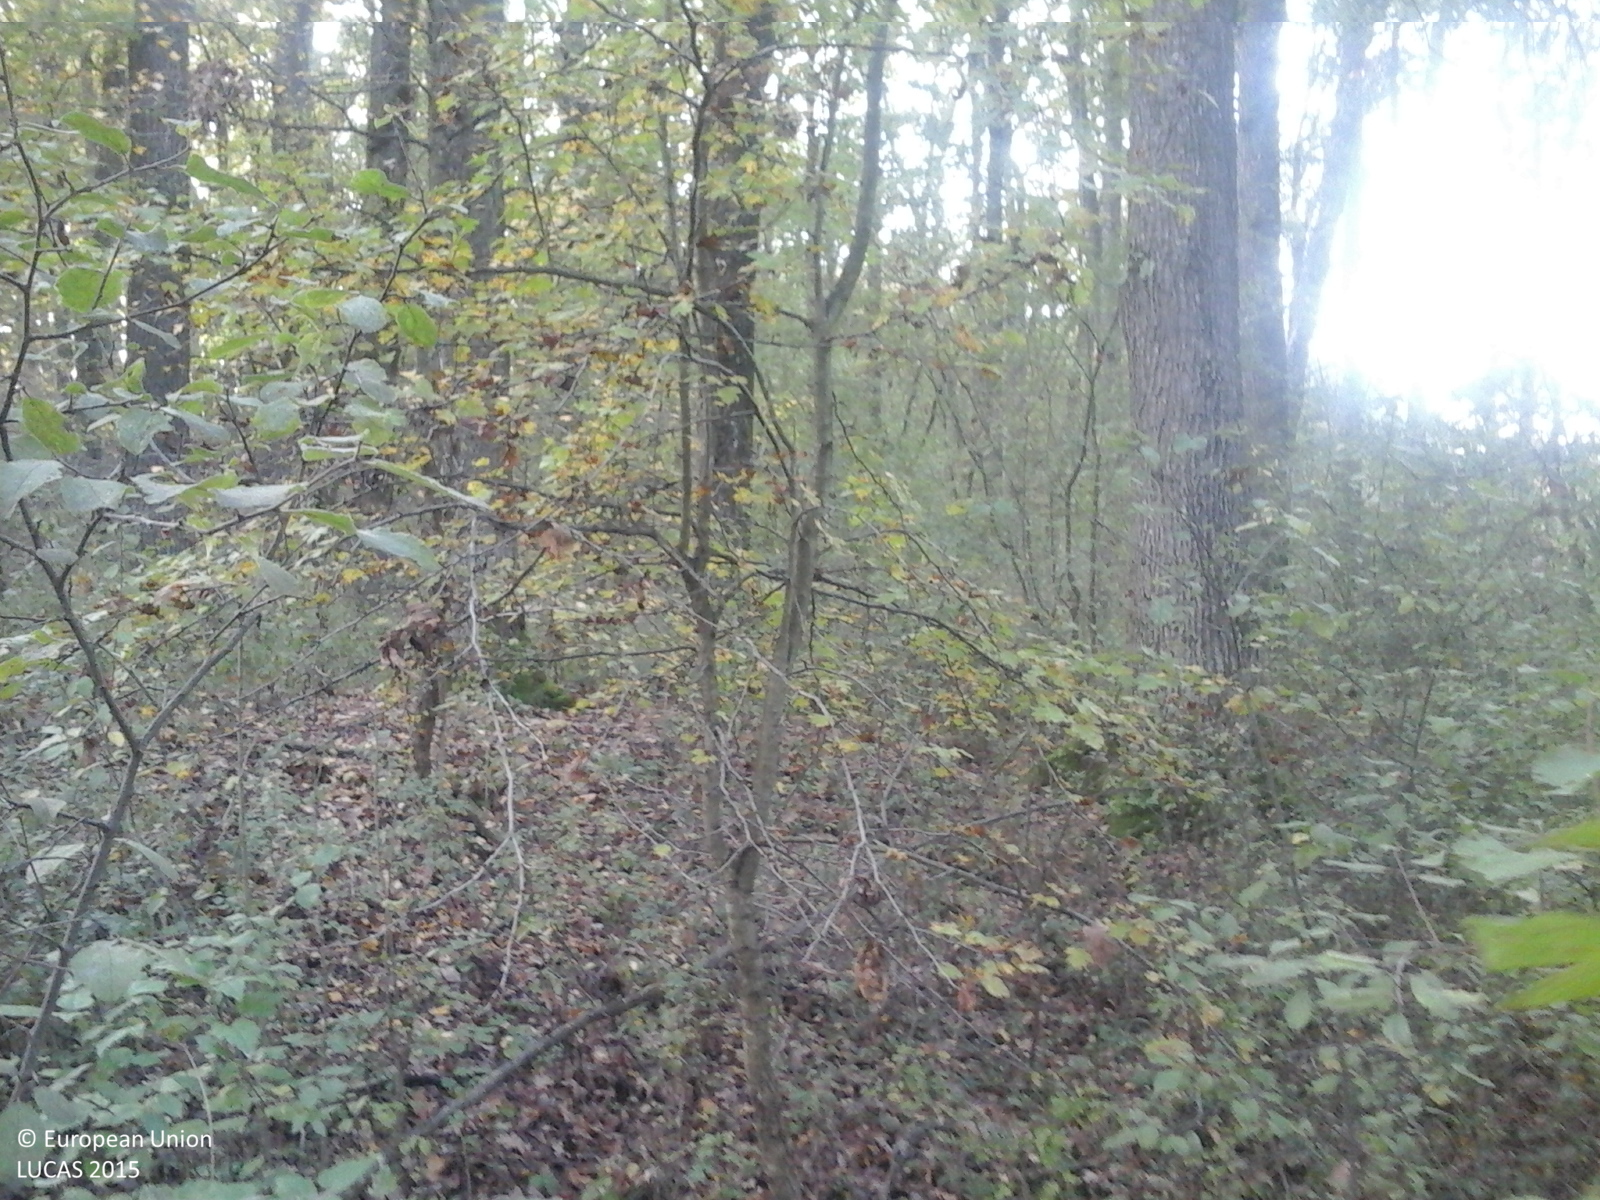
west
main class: Woodland
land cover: Broadleaved woodland
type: acidophilous oak and oak-birch forest
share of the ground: > 75 %
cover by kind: broadleaved forest trees 100 %
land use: Forestry
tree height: > 5 m
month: October
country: RO
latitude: 45.8793
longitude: 24.9474
